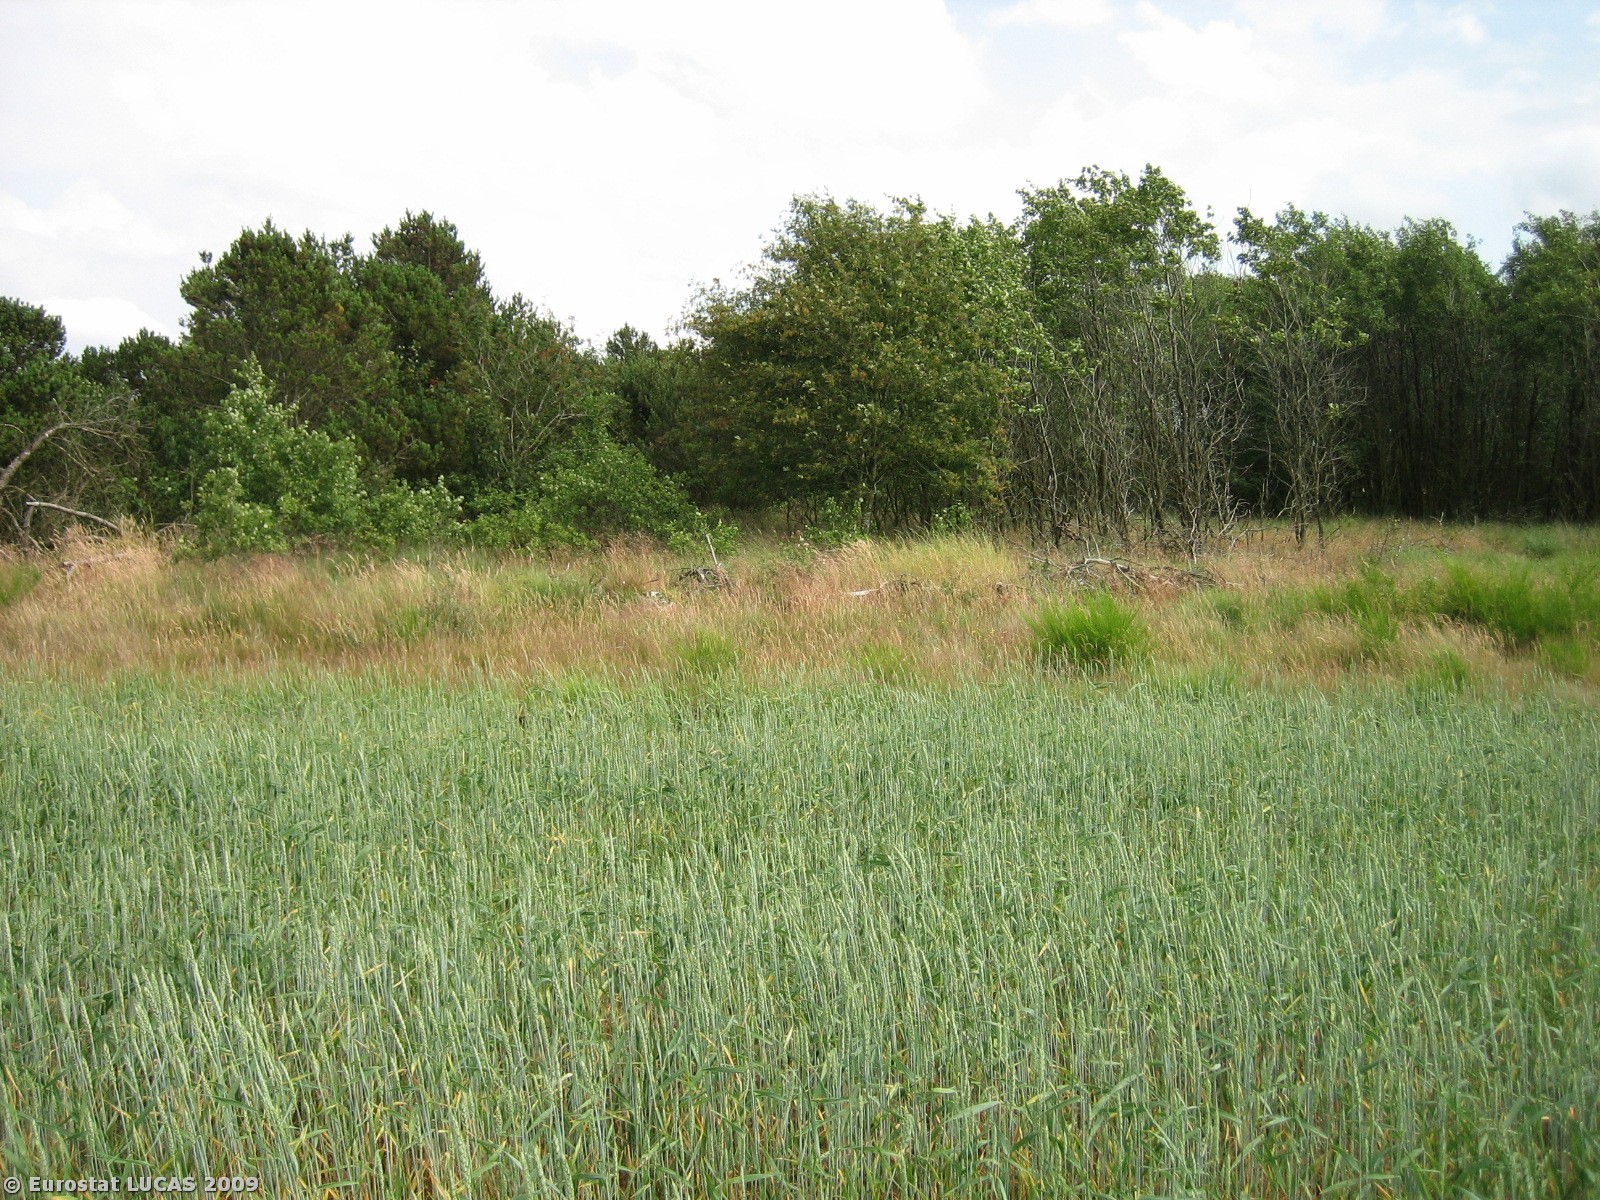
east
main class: Cropland
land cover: Triticale
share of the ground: > 75 %
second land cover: Spontaneously vegetated surfaces
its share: 50 - 75 %
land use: Agriculture (excluding fallow land and kitchen gardens)
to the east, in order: Triticale; Spontaneously vegetated surfaces; Grassland without tree/shrub cover; Mixed woodland; Fences; Grassland without tree/shrub cover
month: July
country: DK
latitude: 55.6076
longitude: 8.8740
